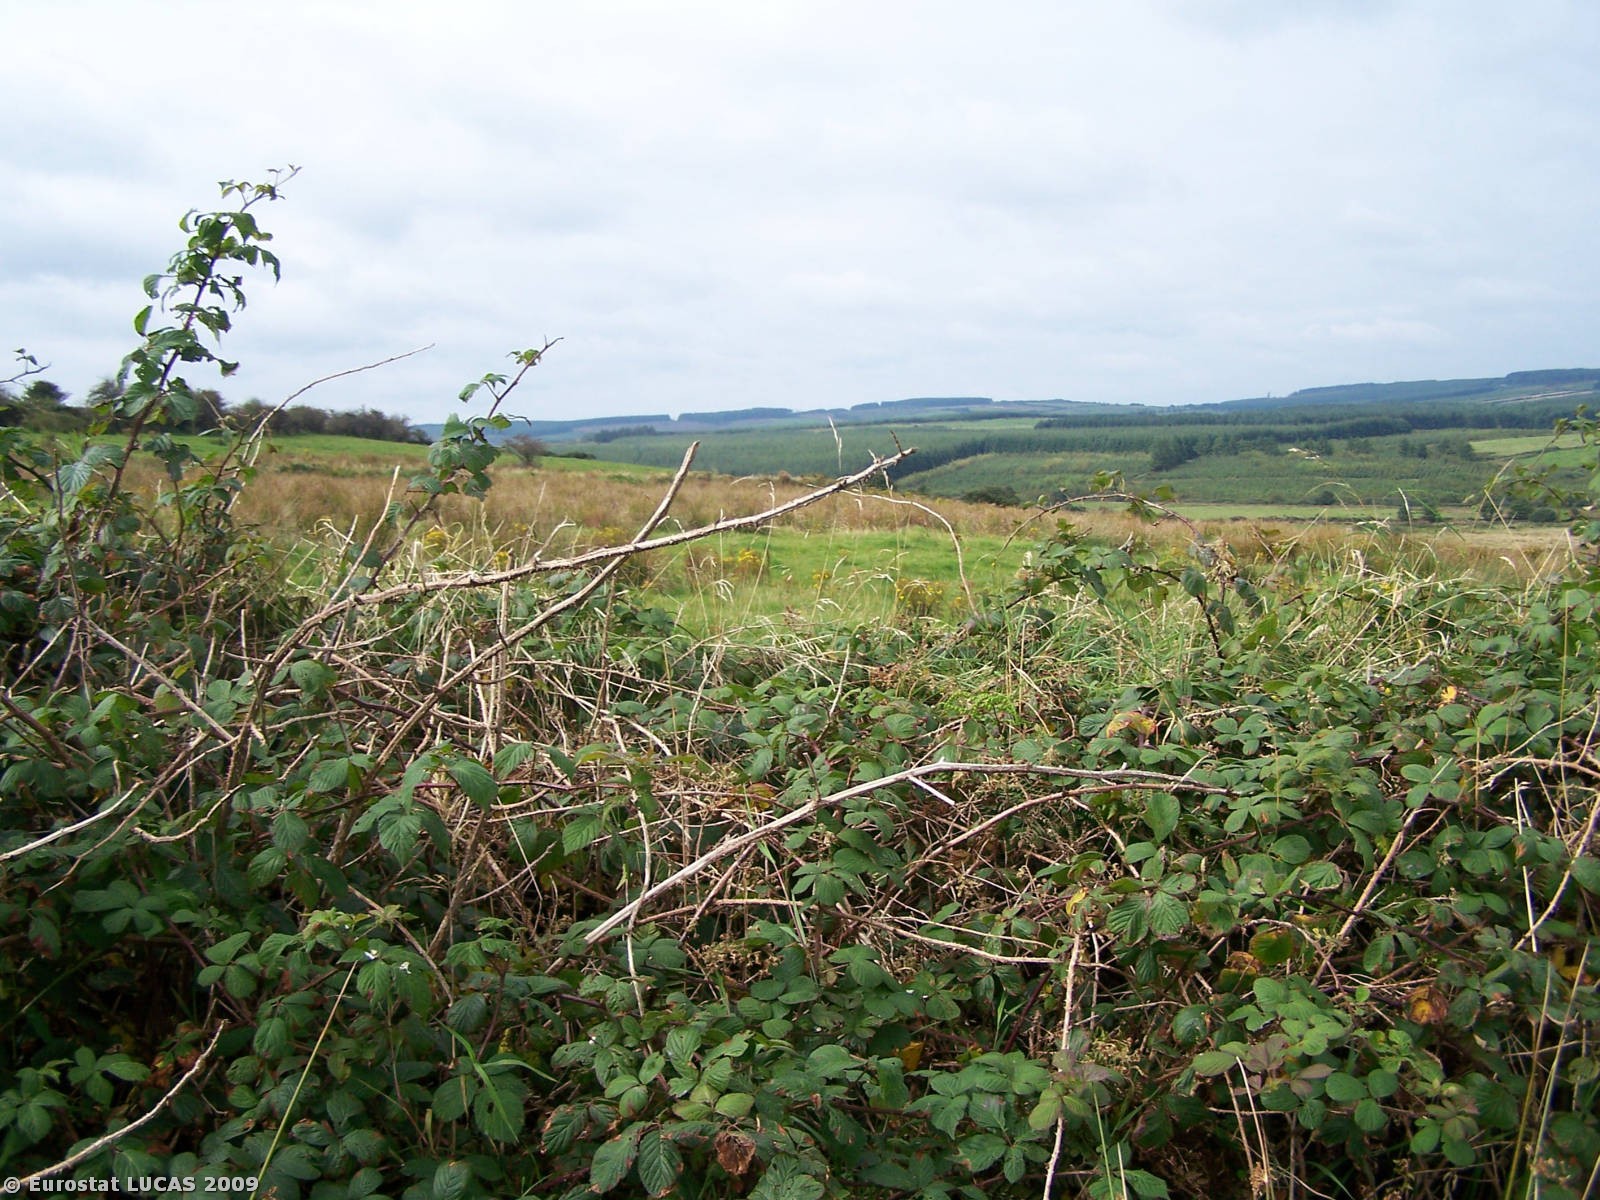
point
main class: Grassland
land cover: Grassland without tree/shrub cover
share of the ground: > 75 %
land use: Agriculture (excluding fallow land and kitchen gardens)
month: September
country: IE
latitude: 52.2801
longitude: -9.0196
